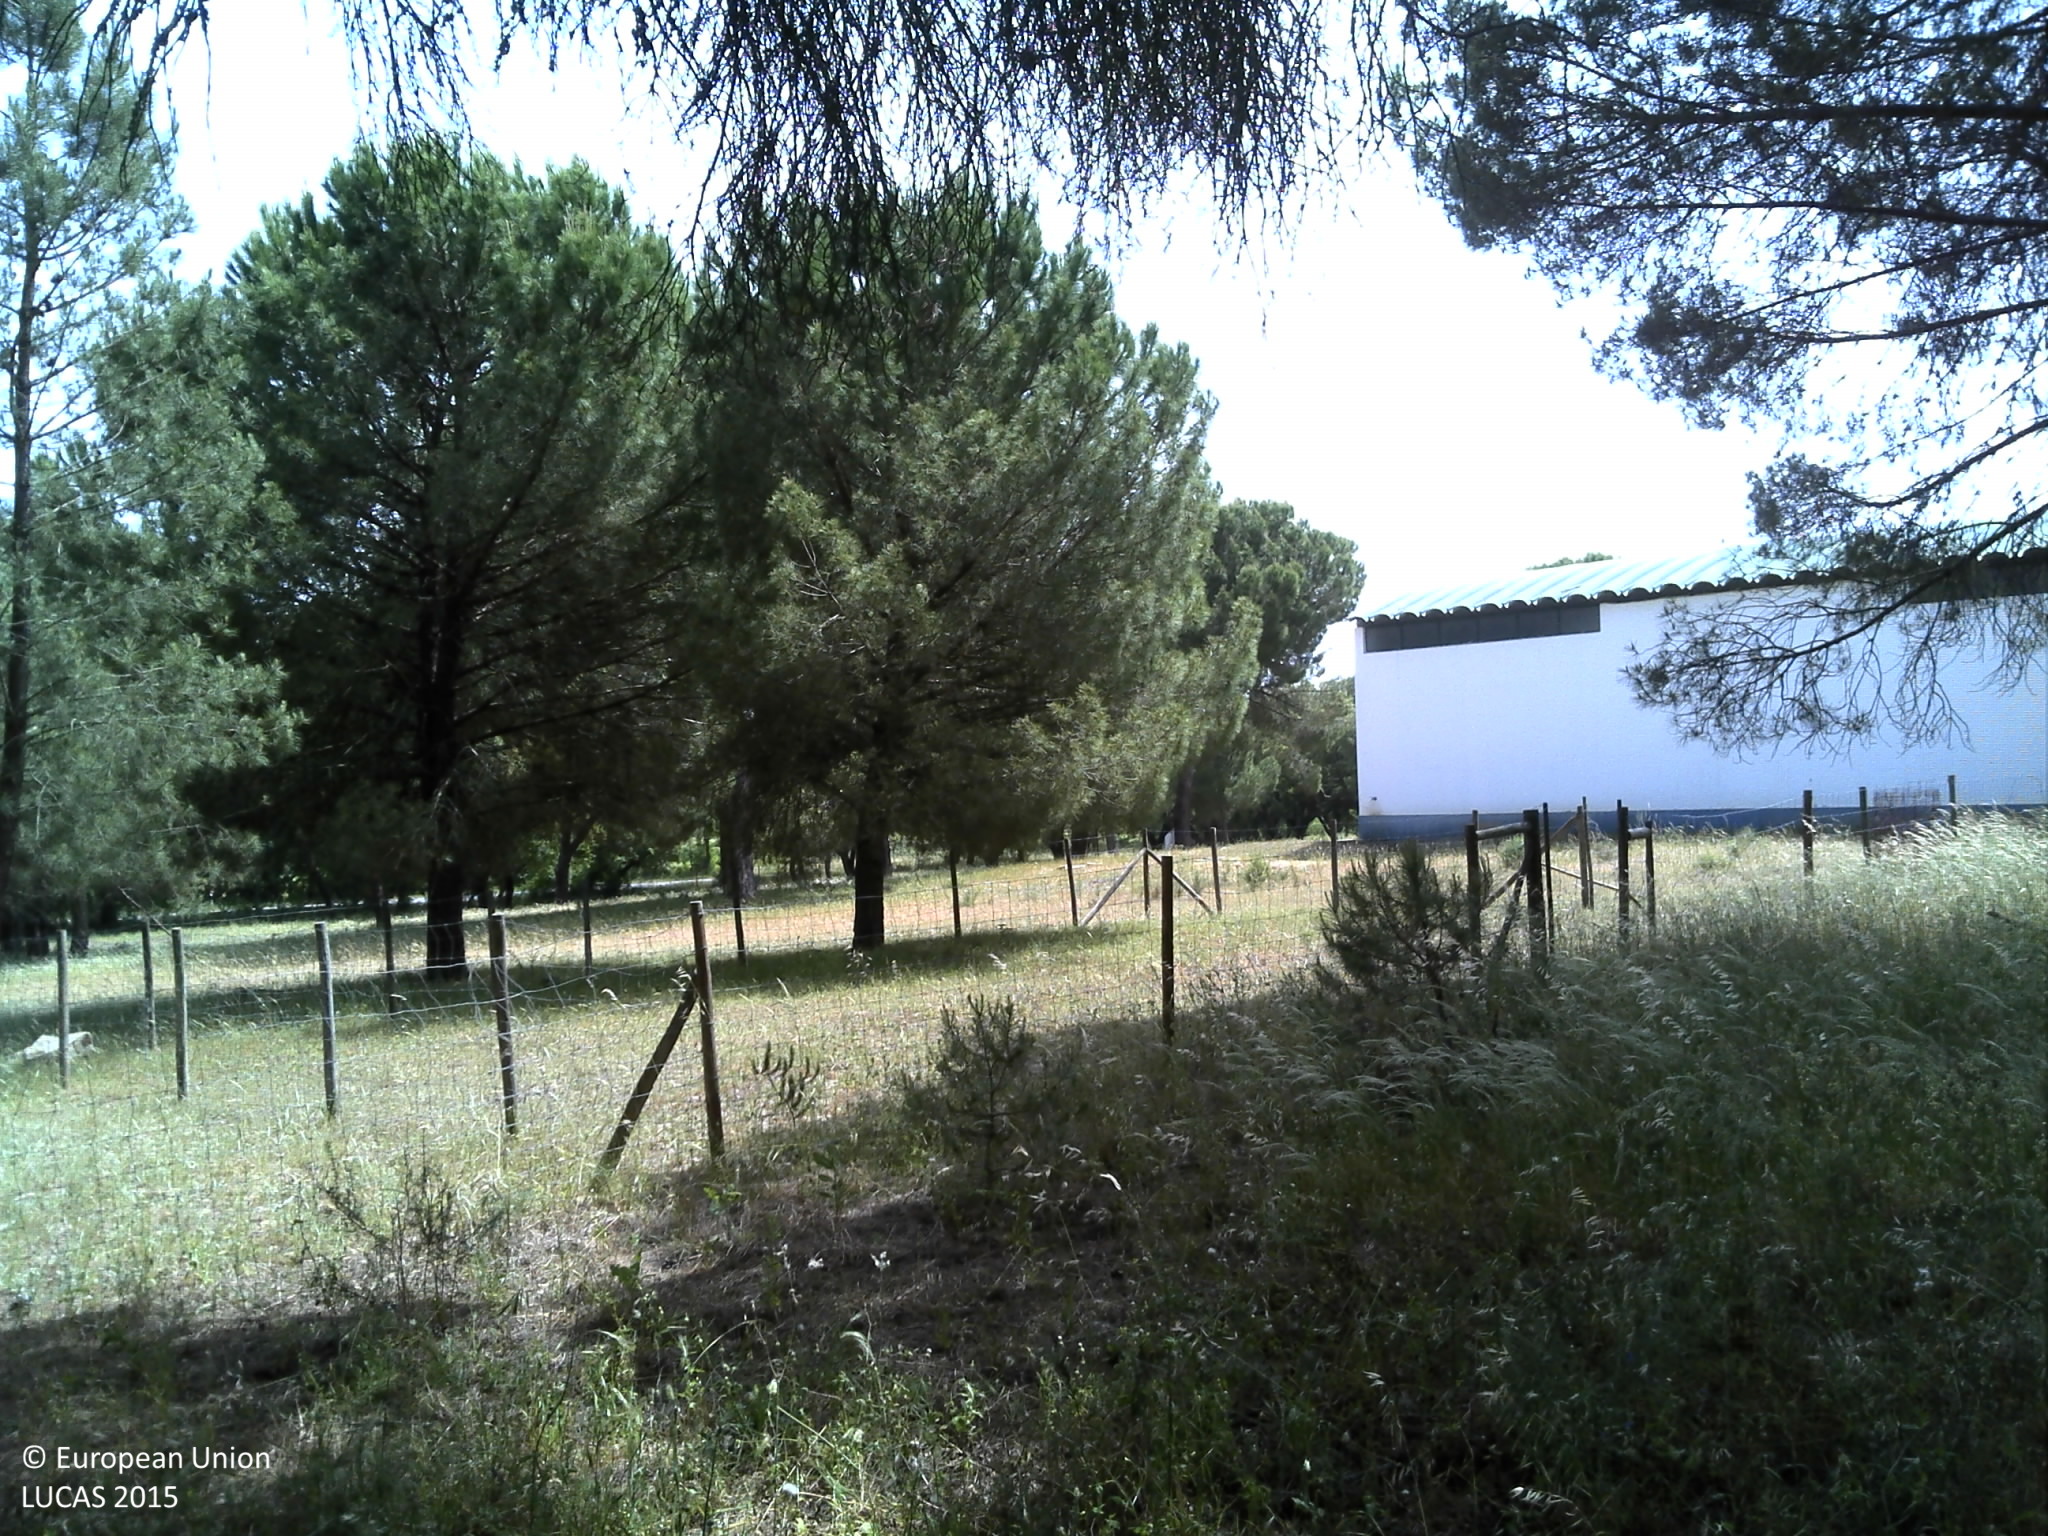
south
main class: Woodland
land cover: Pine dominated coniferous woodland
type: coniferous forest of the mediterranean region
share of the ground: > 75 %
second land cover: Spontaneously vegetated surfaces
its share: > 75 %
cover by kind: coniferous forest trees 75 %, herbaceous plants 25 %
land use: Forestry
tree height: > 5 m
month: May
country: PT
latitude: 38.3853
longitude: -8.4702
